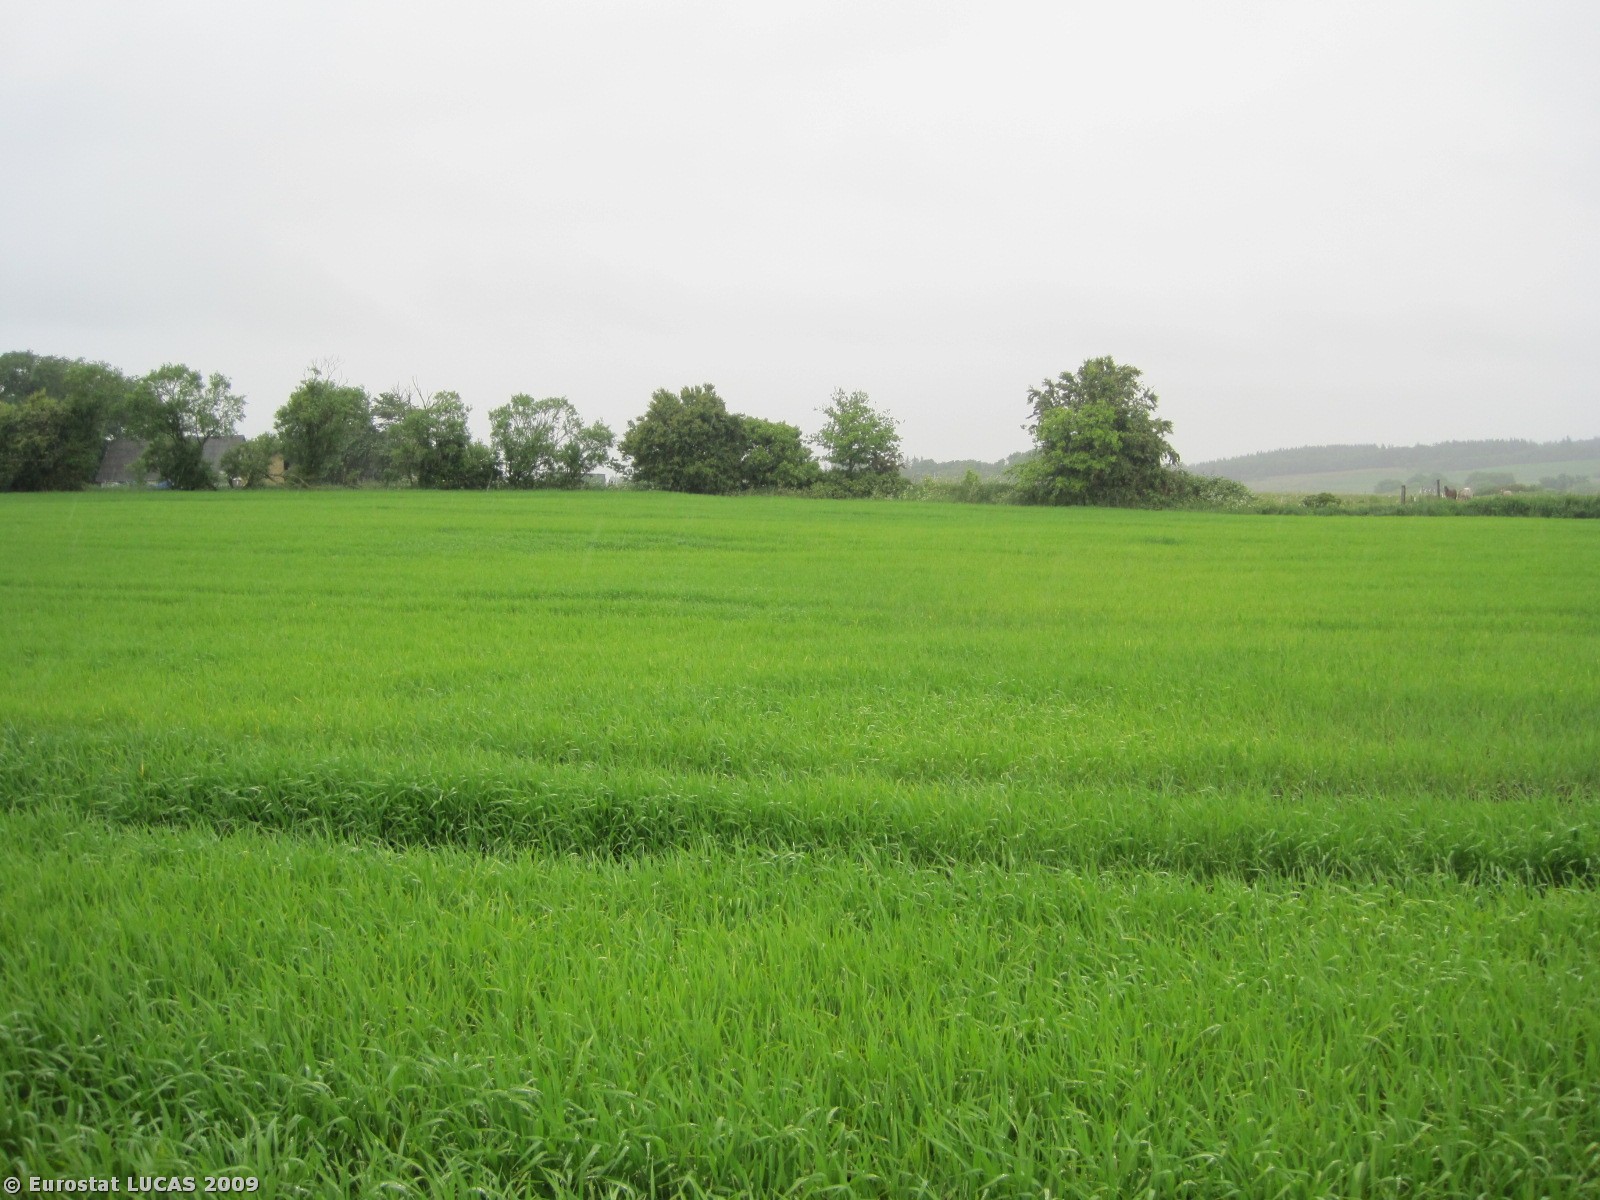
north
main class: Cropland
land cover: Barley
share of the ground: > 75 %
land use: Agriculture (excluding fallow land and kitchen gardens)
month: June
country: DK
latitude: 57.3563
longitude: 10.0830
